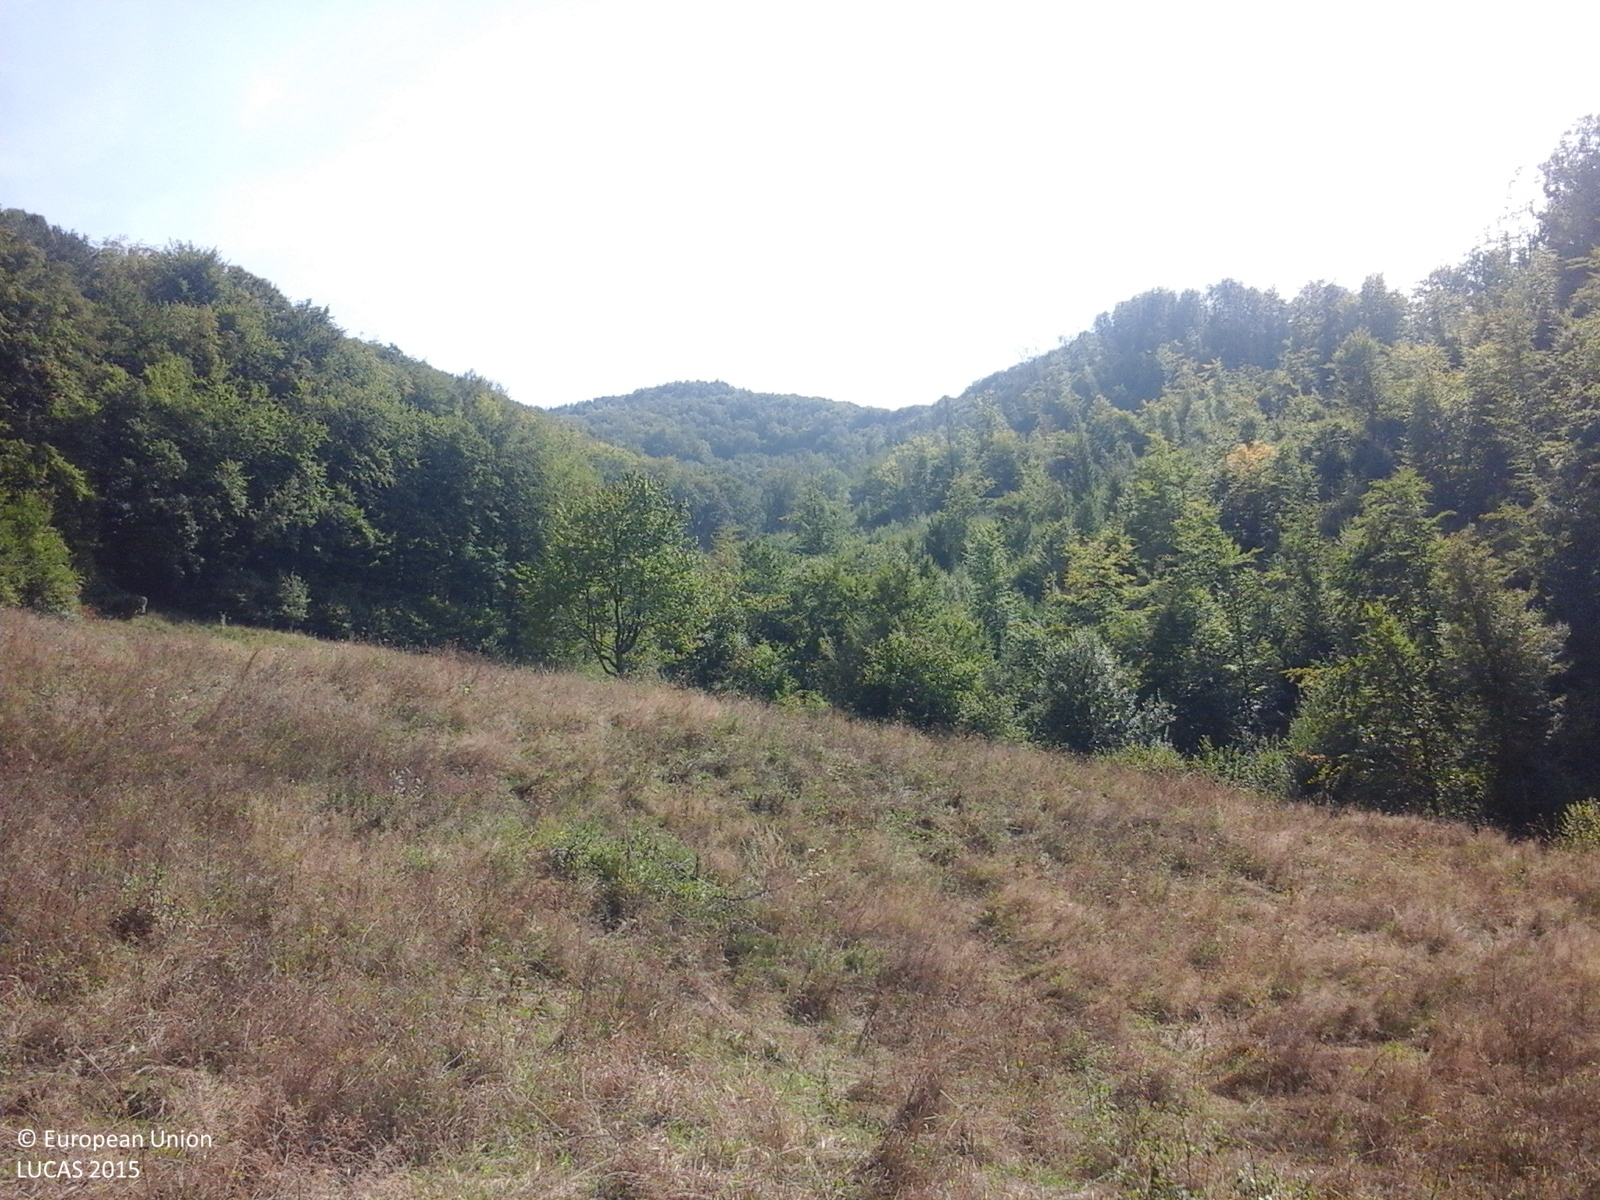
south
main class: Grassland
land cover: Spontaneously vegetated surfaces
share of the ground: > 75 %
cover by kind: herbaceous plants 100 %
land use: Fallow land
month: September
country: RO
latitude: 47.2394
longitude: 23.6686
